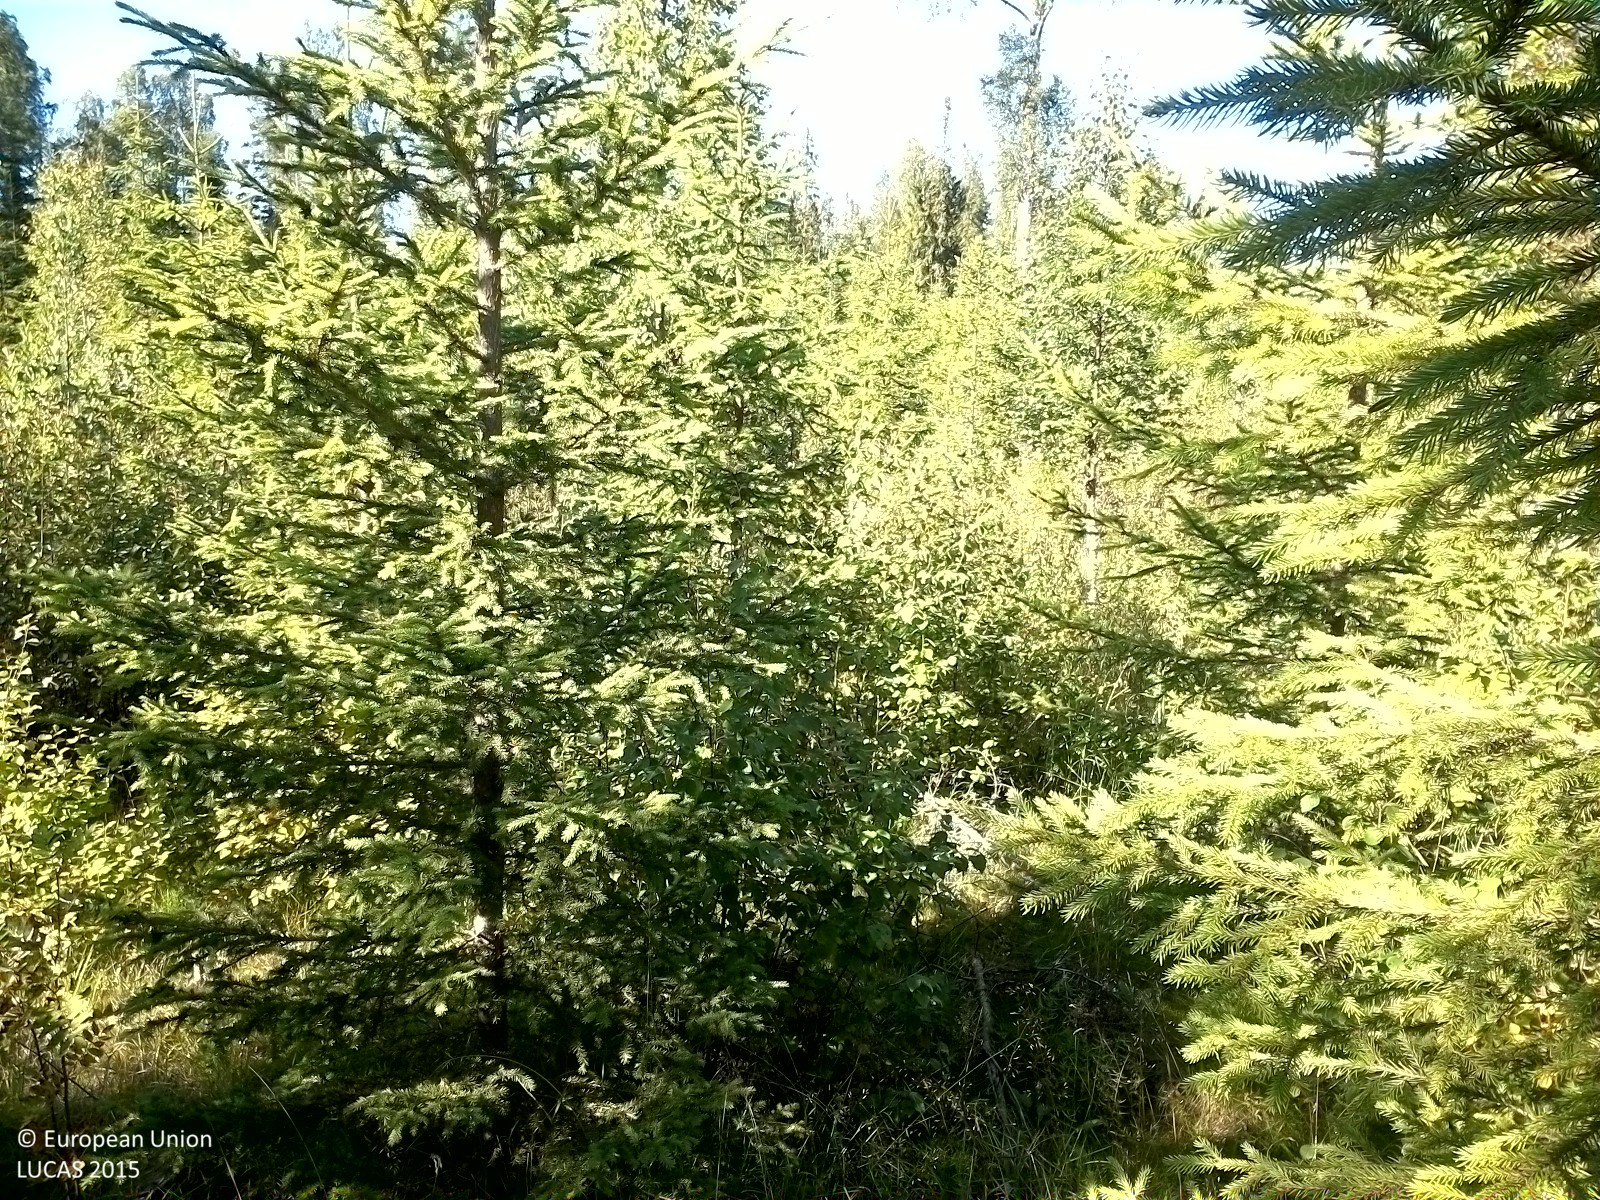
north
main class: Woodland
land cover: Spruce dominated mixed woodland
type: boreal forest
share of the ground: 50 - 75 %
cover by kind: herbaceous plants 50 %, coniferous forest trees 35 %, broadleaved forest trees 15 %
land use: Forestry
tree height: < 5 m
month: August
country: SE
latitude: 62.2953
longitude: 16.4006
